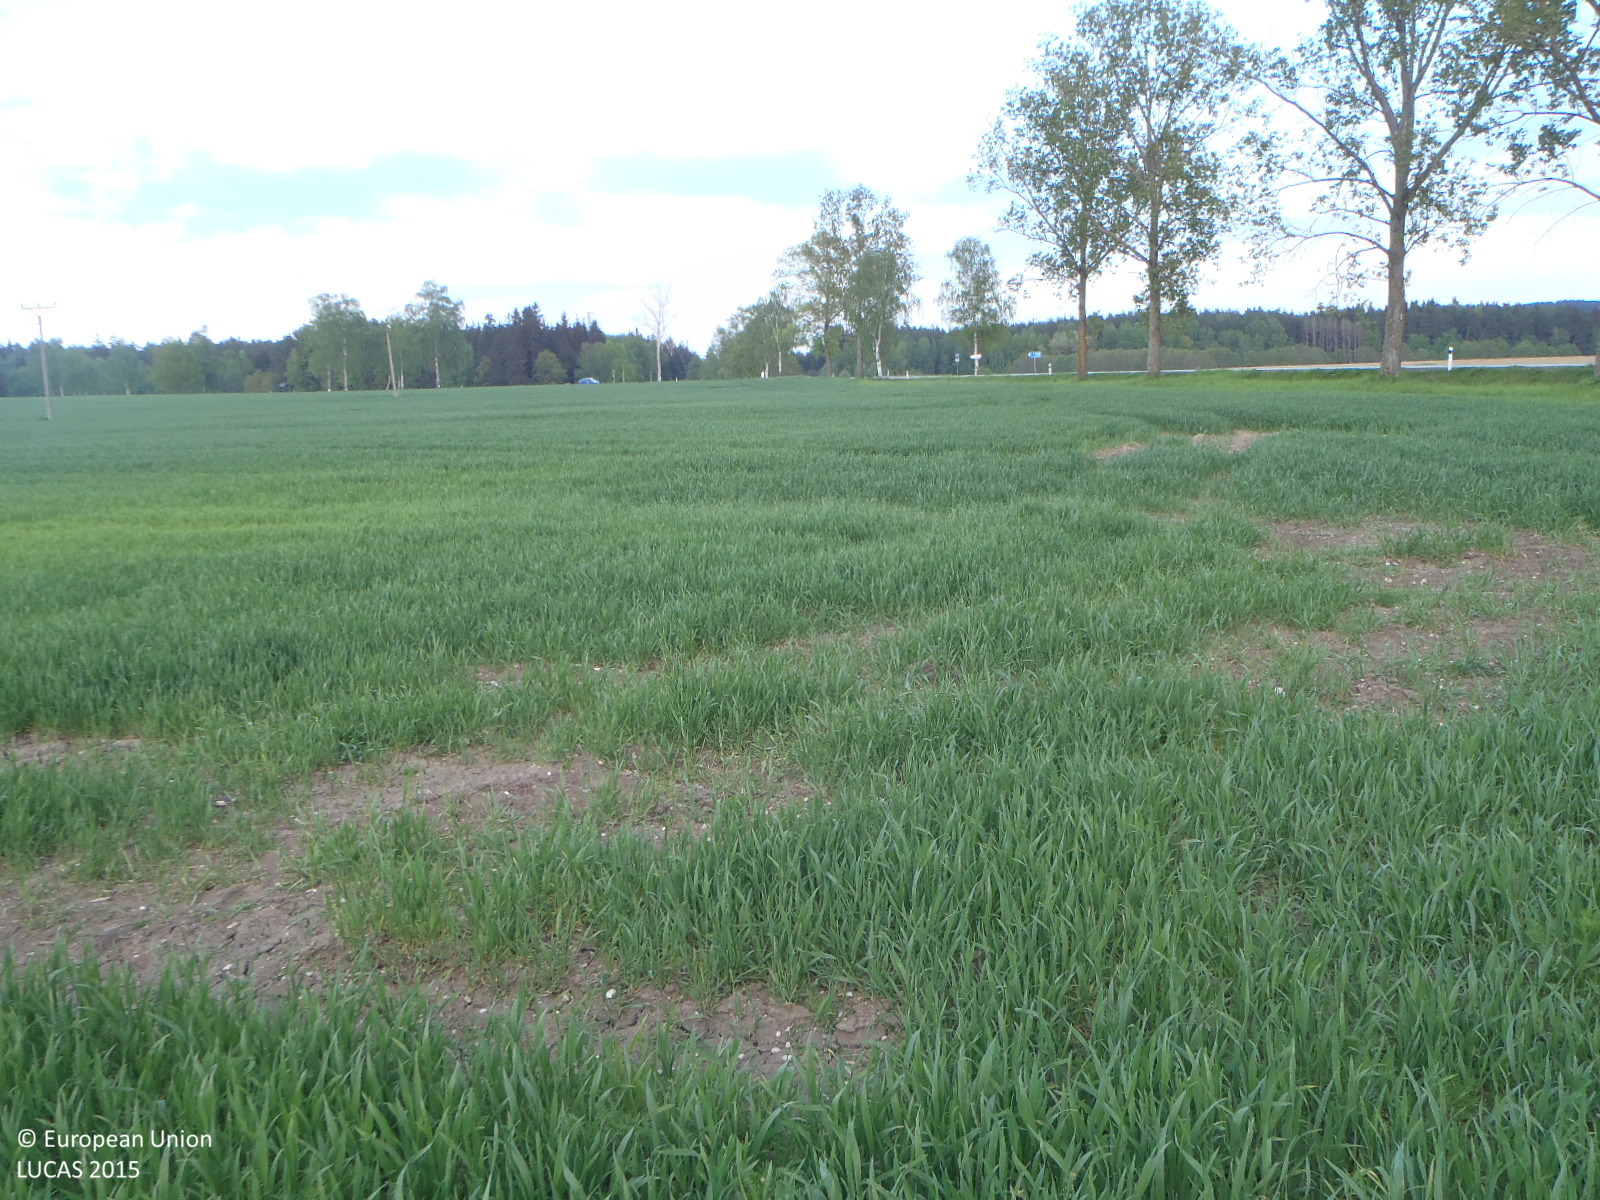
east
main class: Cropland
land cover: Triticale
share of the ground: 50 - 75 %
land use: Agriculture (excluding fallow land and kitchen gardens)
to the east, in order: Triticale; Electric lines; Triticale
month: May
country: CZ
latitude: 49.1349
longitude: 15.0599
